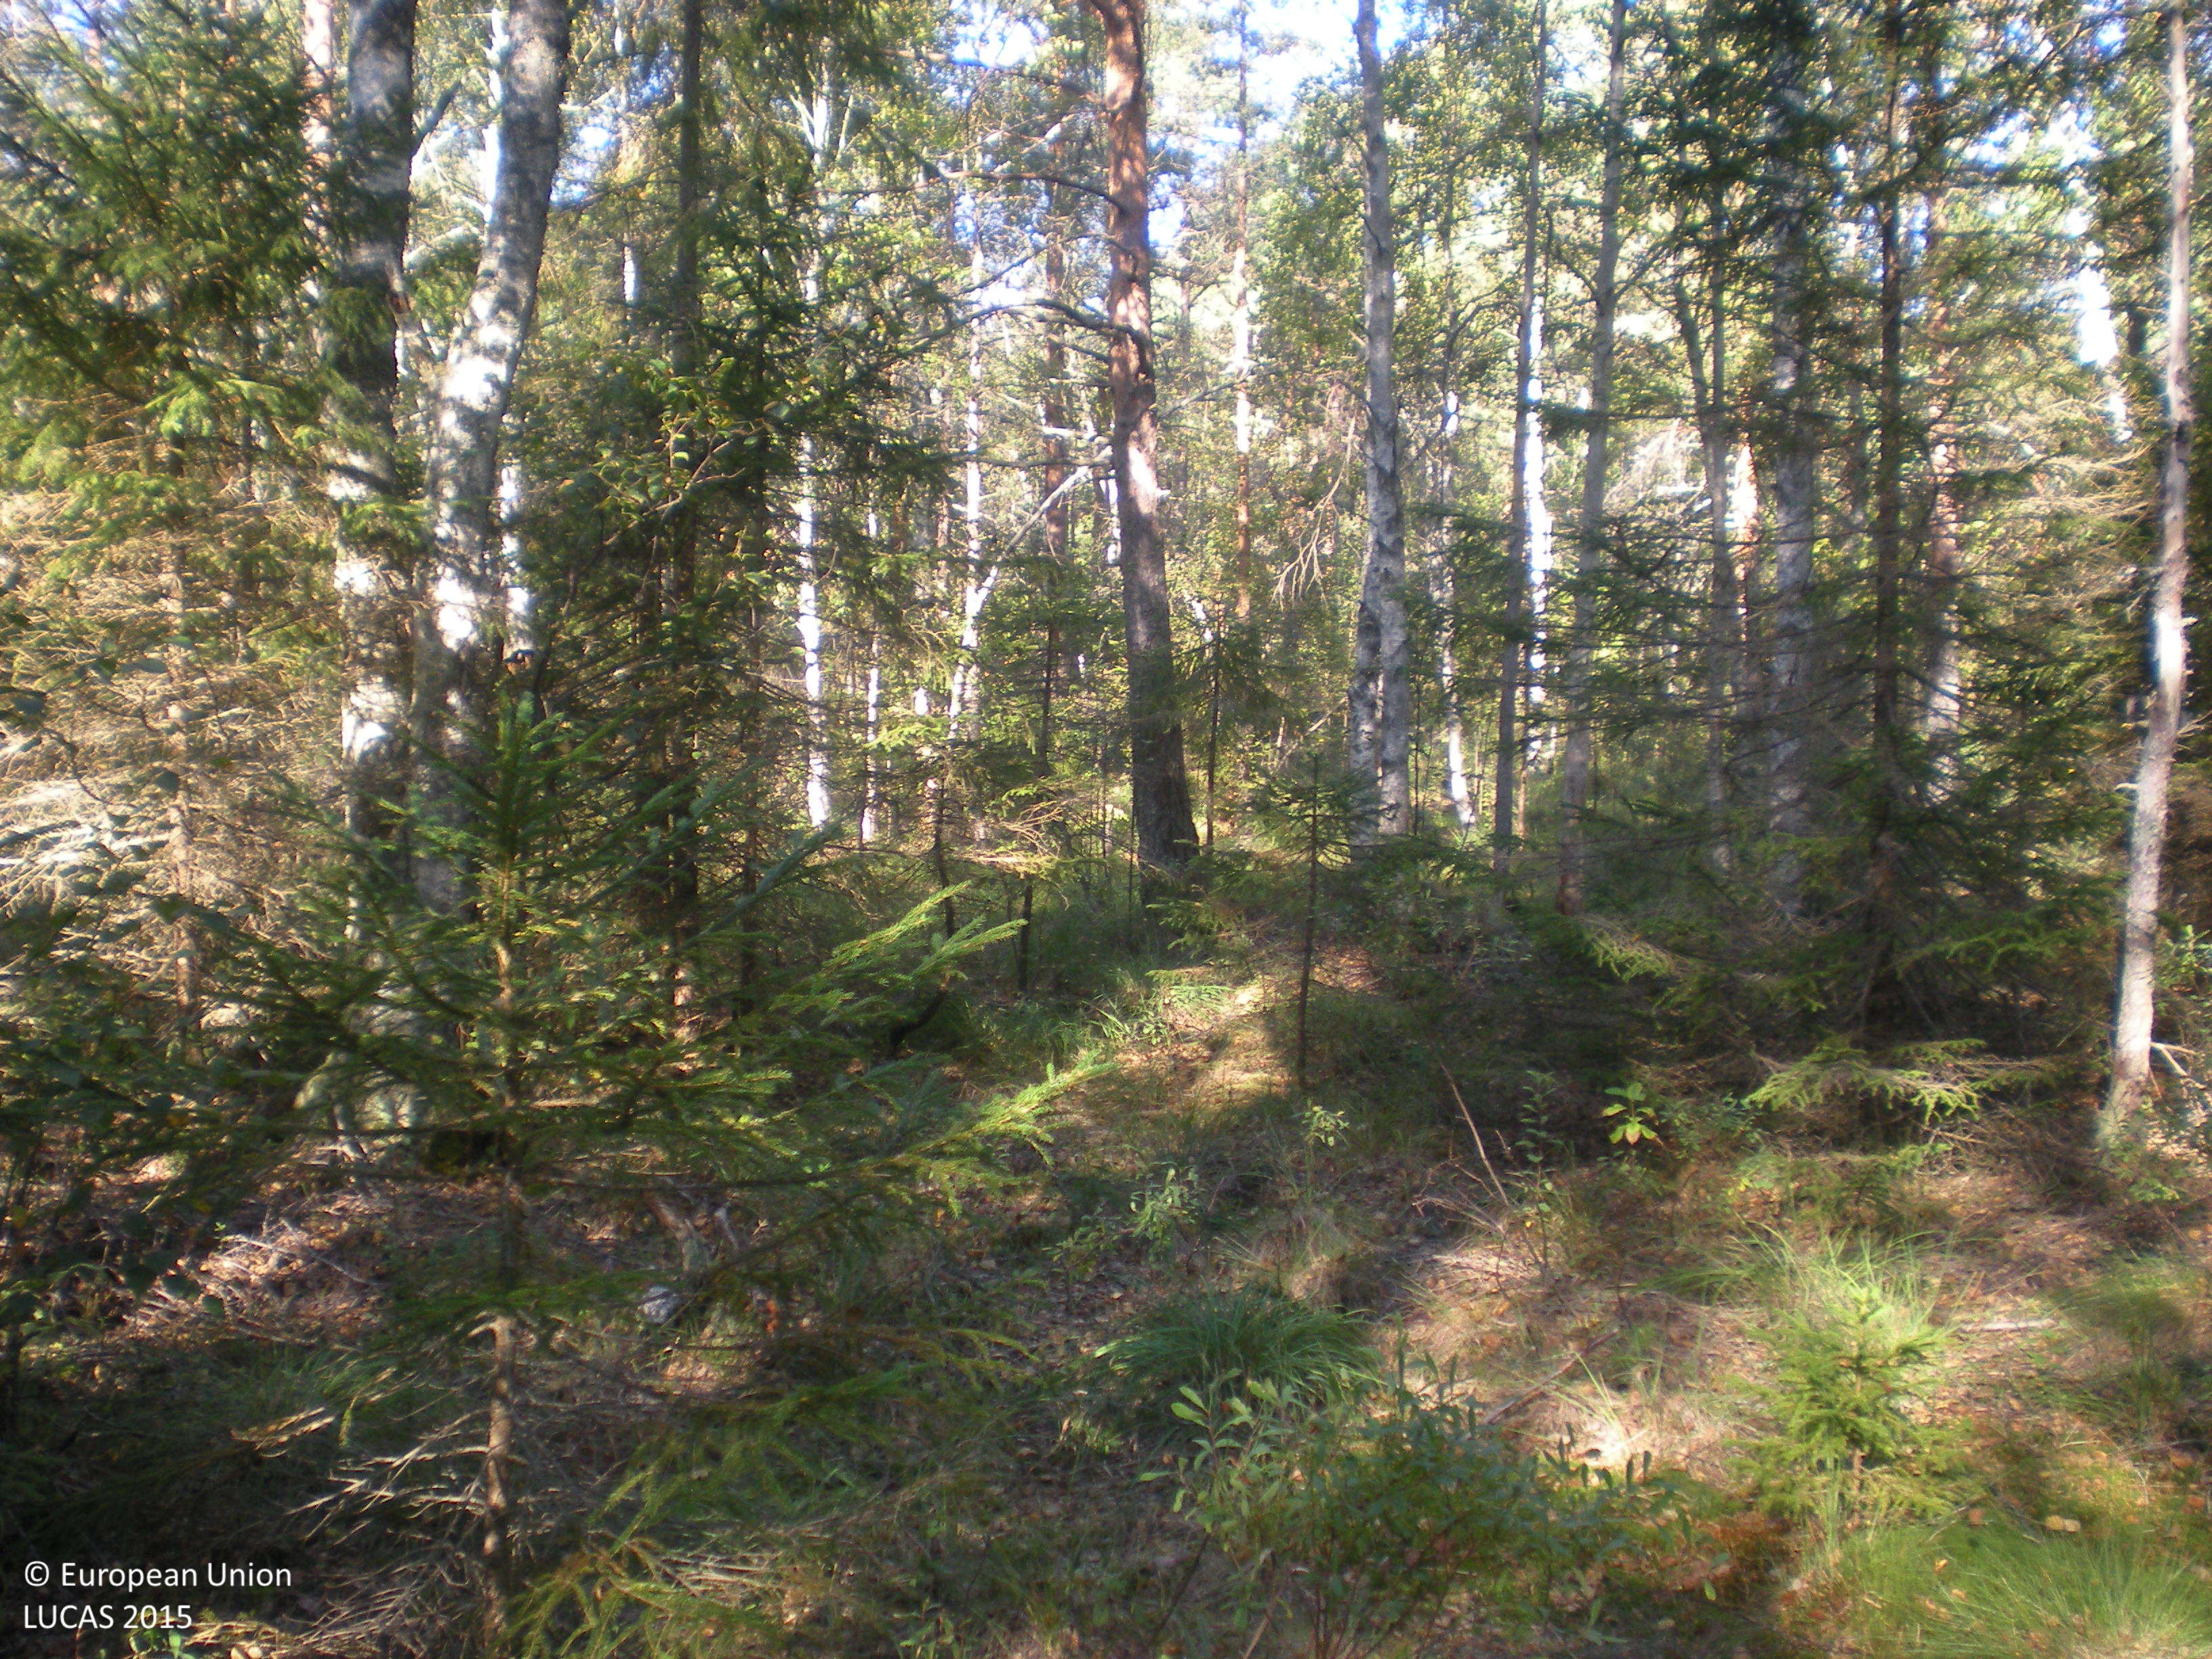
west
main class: Woodland
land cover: Pine dominated mixed woodland
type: boreal forest
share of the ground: 50 - 75 %
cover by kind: coniferous forest trees 40 %, broadleaved forest trees 25 %, herbaceous plants 15 %, lichens and mosses 10 %, shrubs 5 %
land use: Forestry
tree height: > 5 m
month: August
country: SE
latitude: 60.5775
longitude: 17.1614
